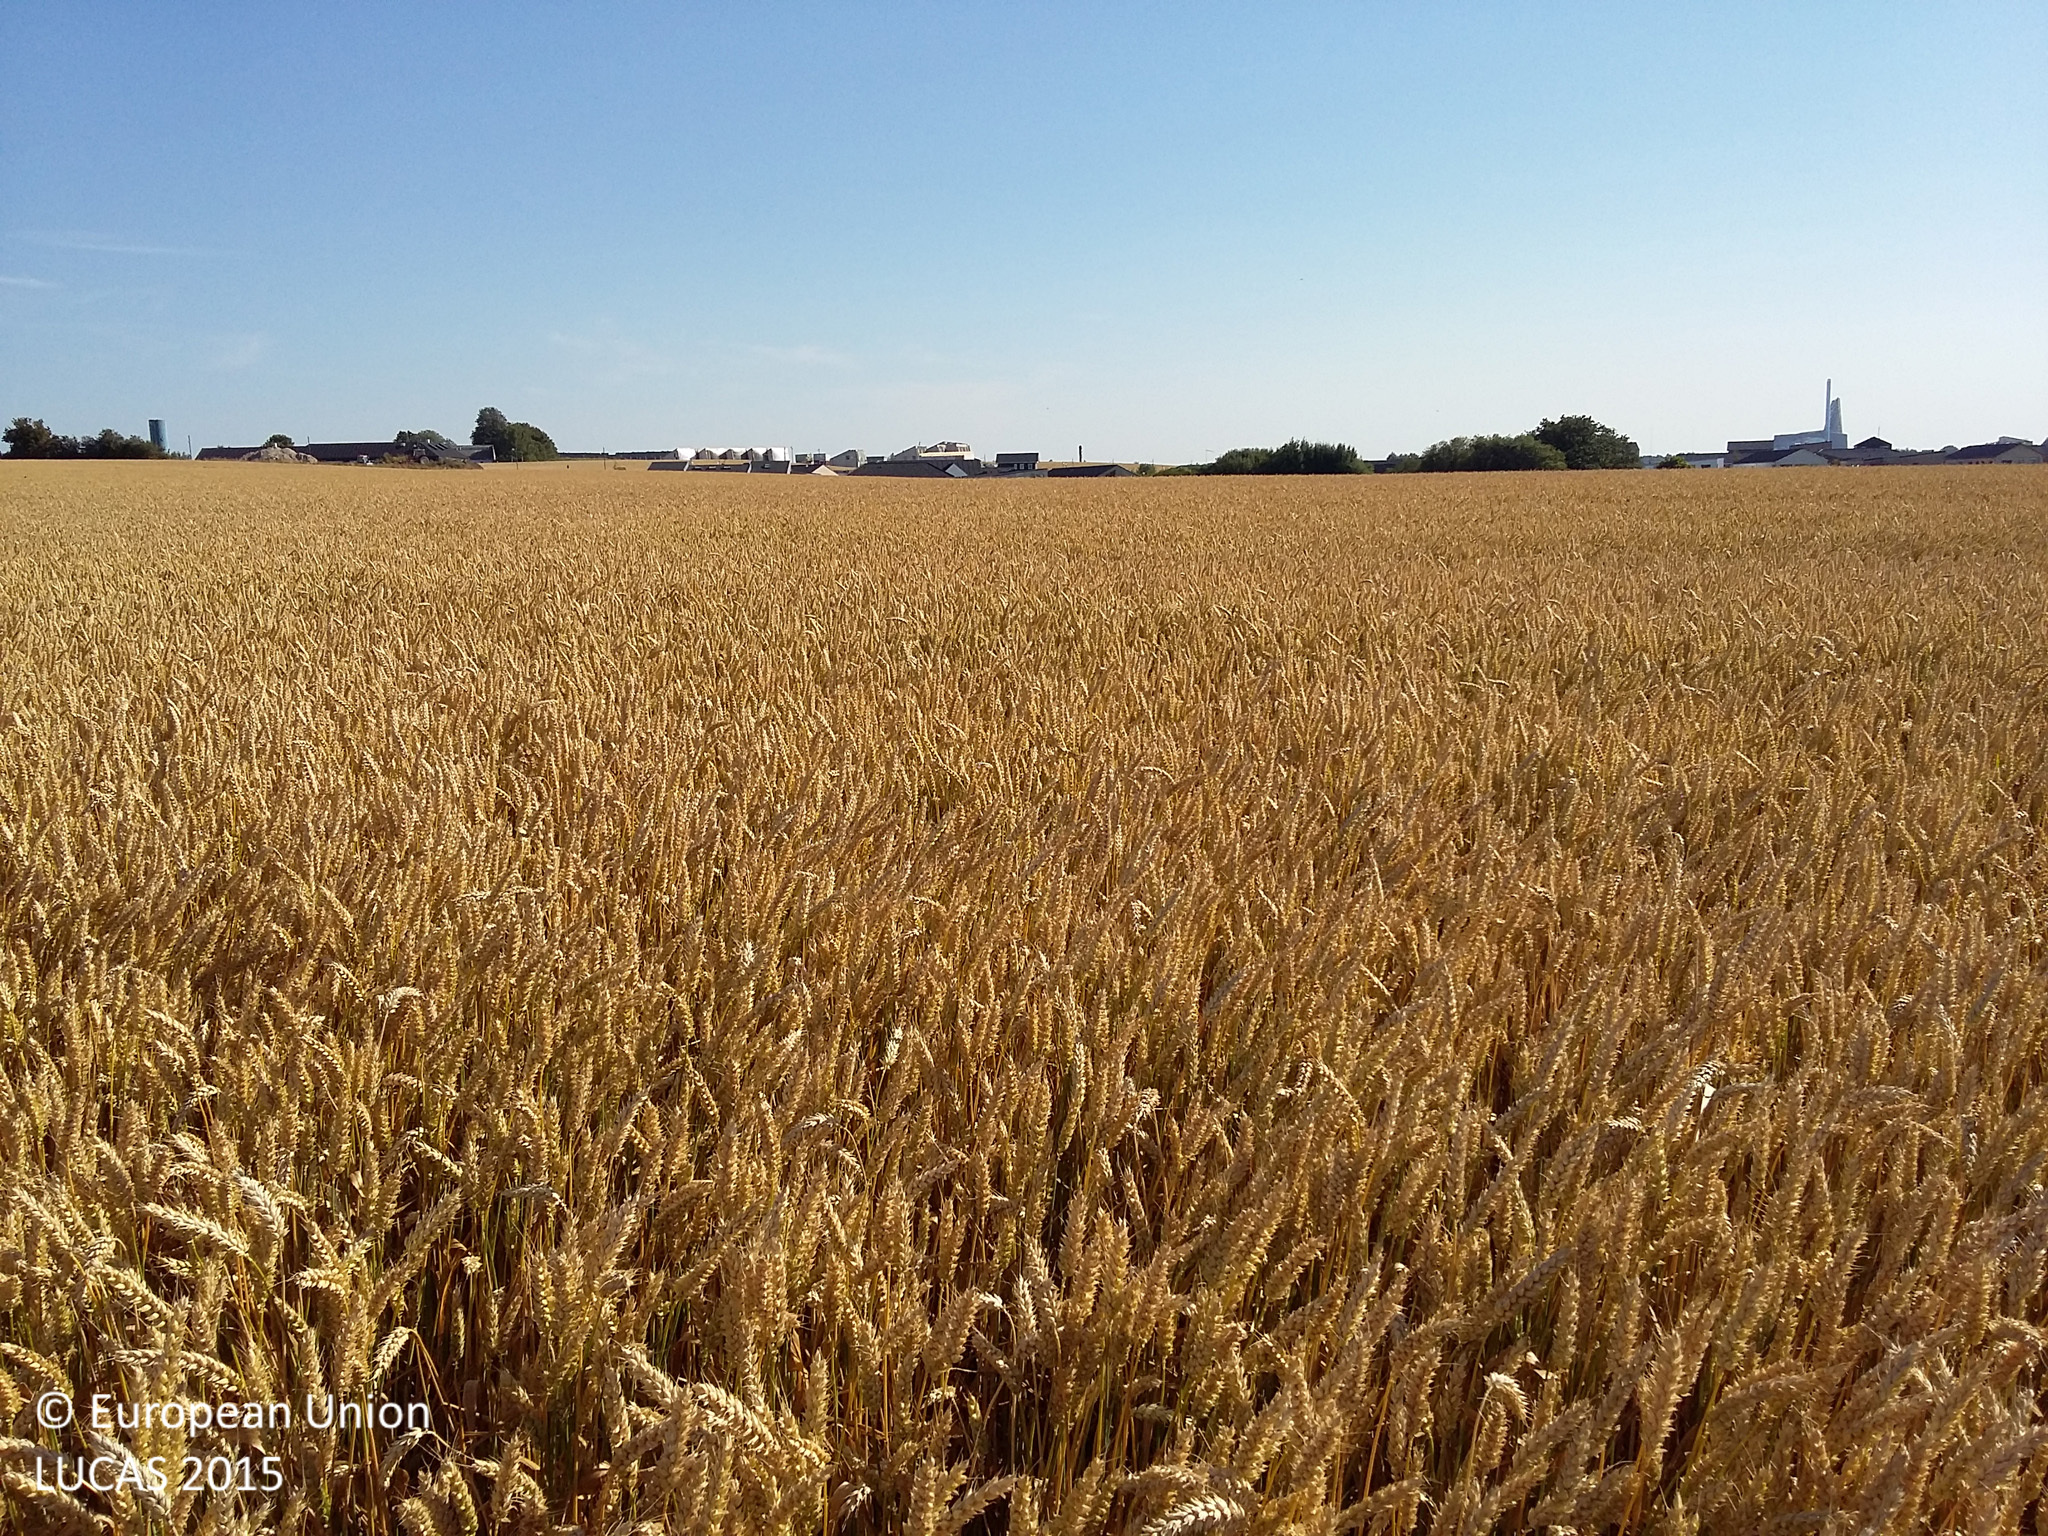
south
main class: Cropland
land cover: Common wheat
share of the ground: > 75 %
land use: Agriculture (excluding fallow land and kitchen gardens)
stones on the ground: < 10 %
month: August
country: DK
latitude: 55.6664
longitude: 12.1444
